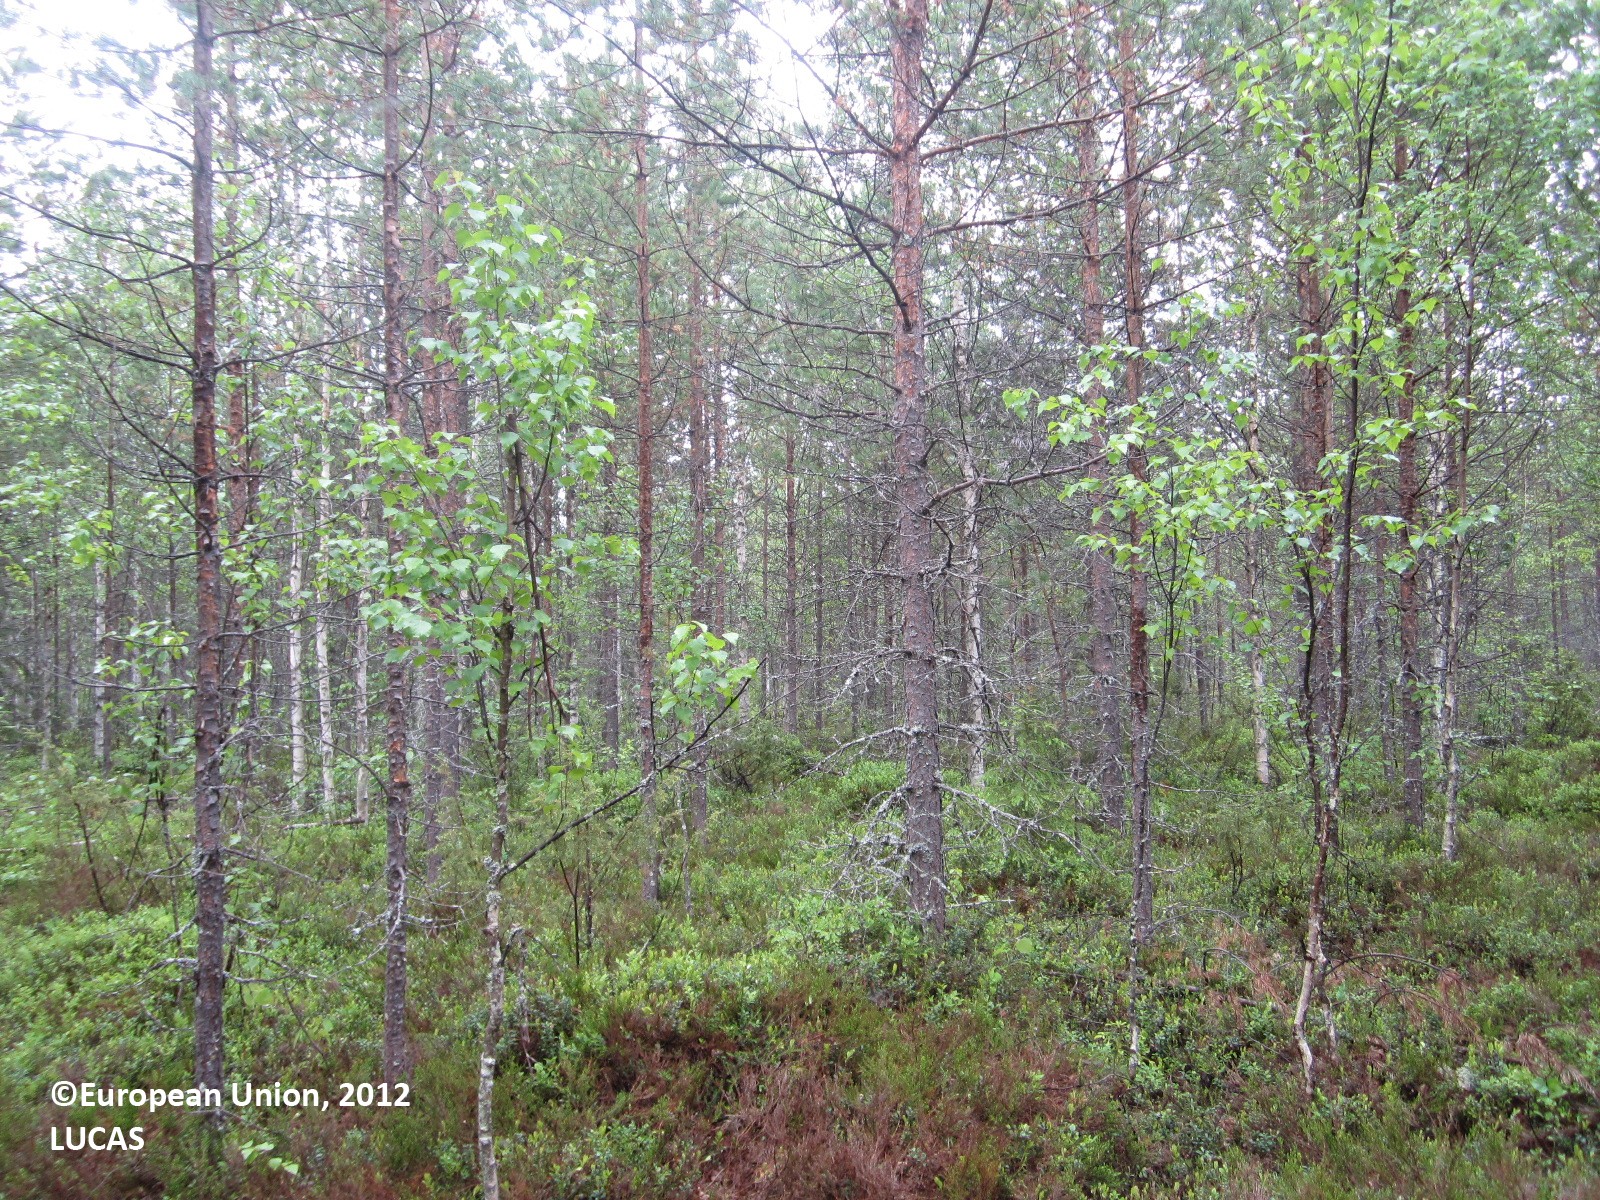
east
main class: Woodland
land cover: Pine dominated mixed woodland
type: boreal forest
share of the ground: 50 - 75 %
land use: Forestry
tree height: > 5 m
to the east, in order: Pine dominated mixed woodland; Tracks; Pine dominated mixed woodland; Ditches and canals; Pine dominated mixed woodland; Pine dominated coniferous woodland; Ditches and canals; Pine dominated coniferous woodland; Pine dominated mixed woodland
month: June
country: FI
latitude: 64.4335
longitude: 29.1193
